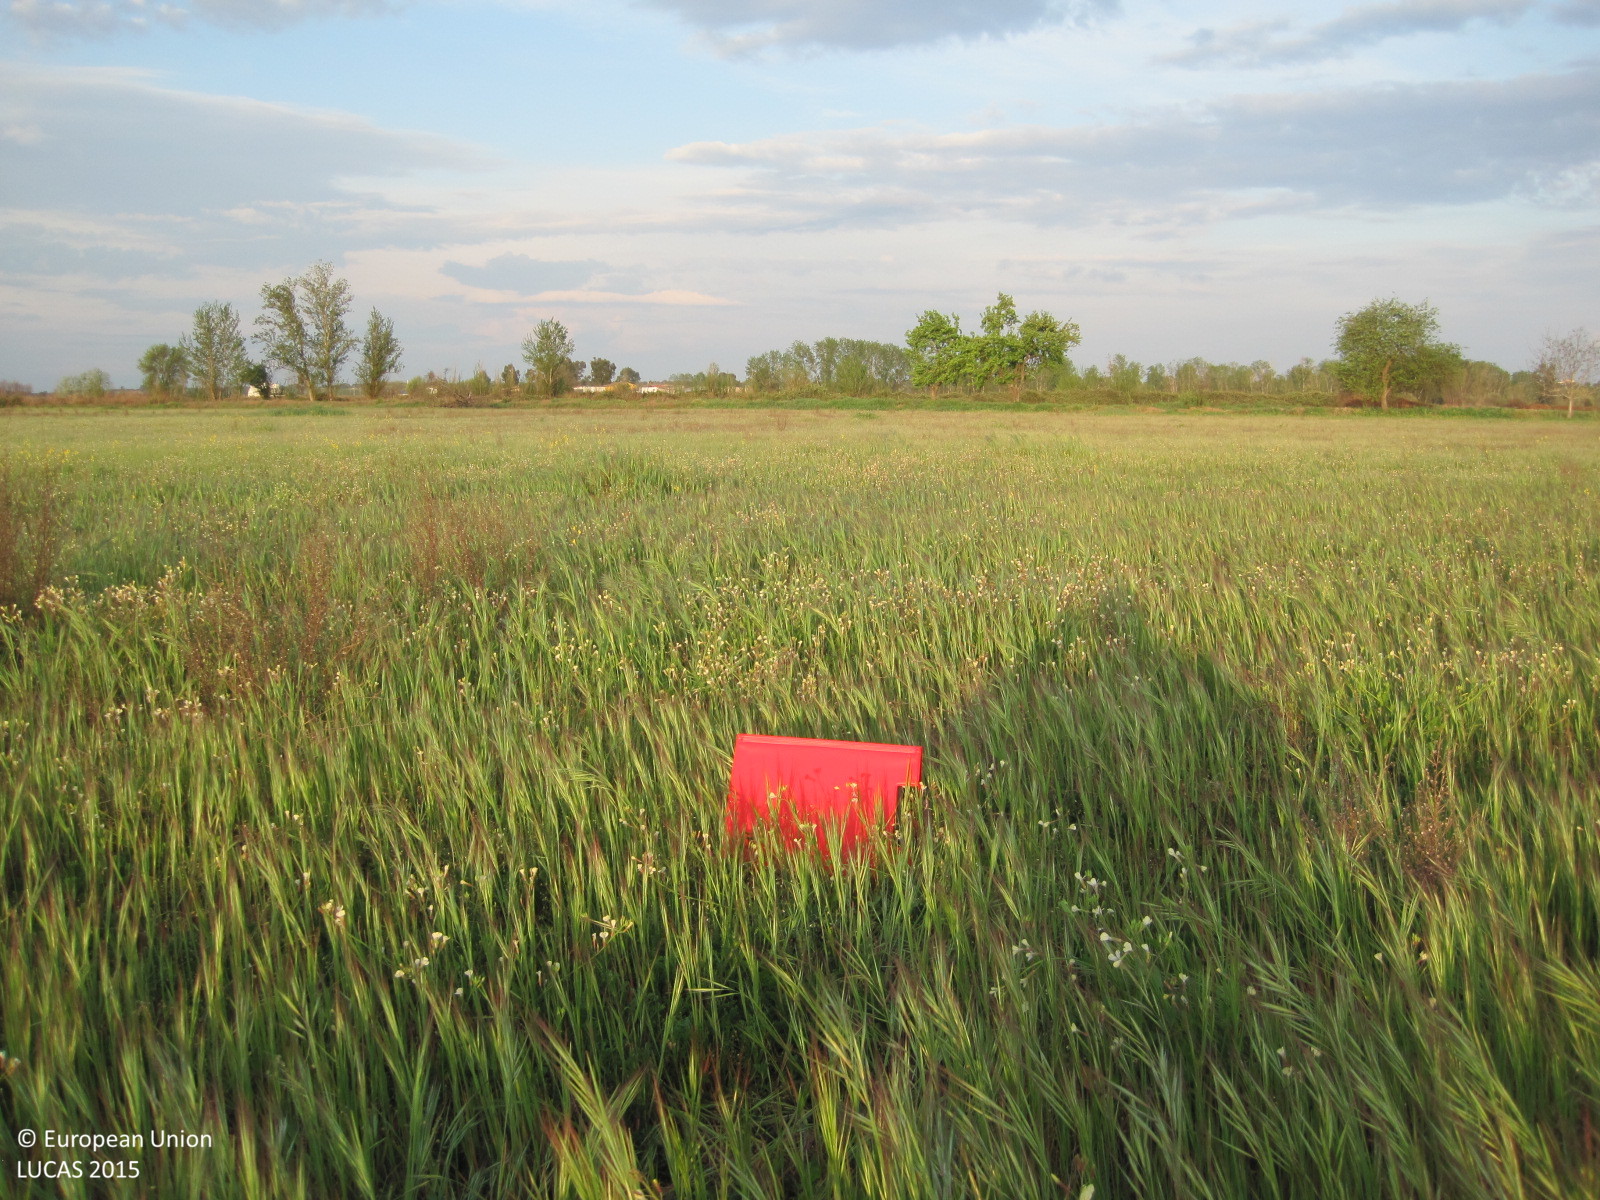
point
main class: Grassland
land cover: Spontaneously vegetated surfaces
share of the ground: > 75 %
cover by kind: herbaceous plants 100 %
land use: Fallow land
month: April
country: ES
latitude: 39.9272
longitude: -4.9205
